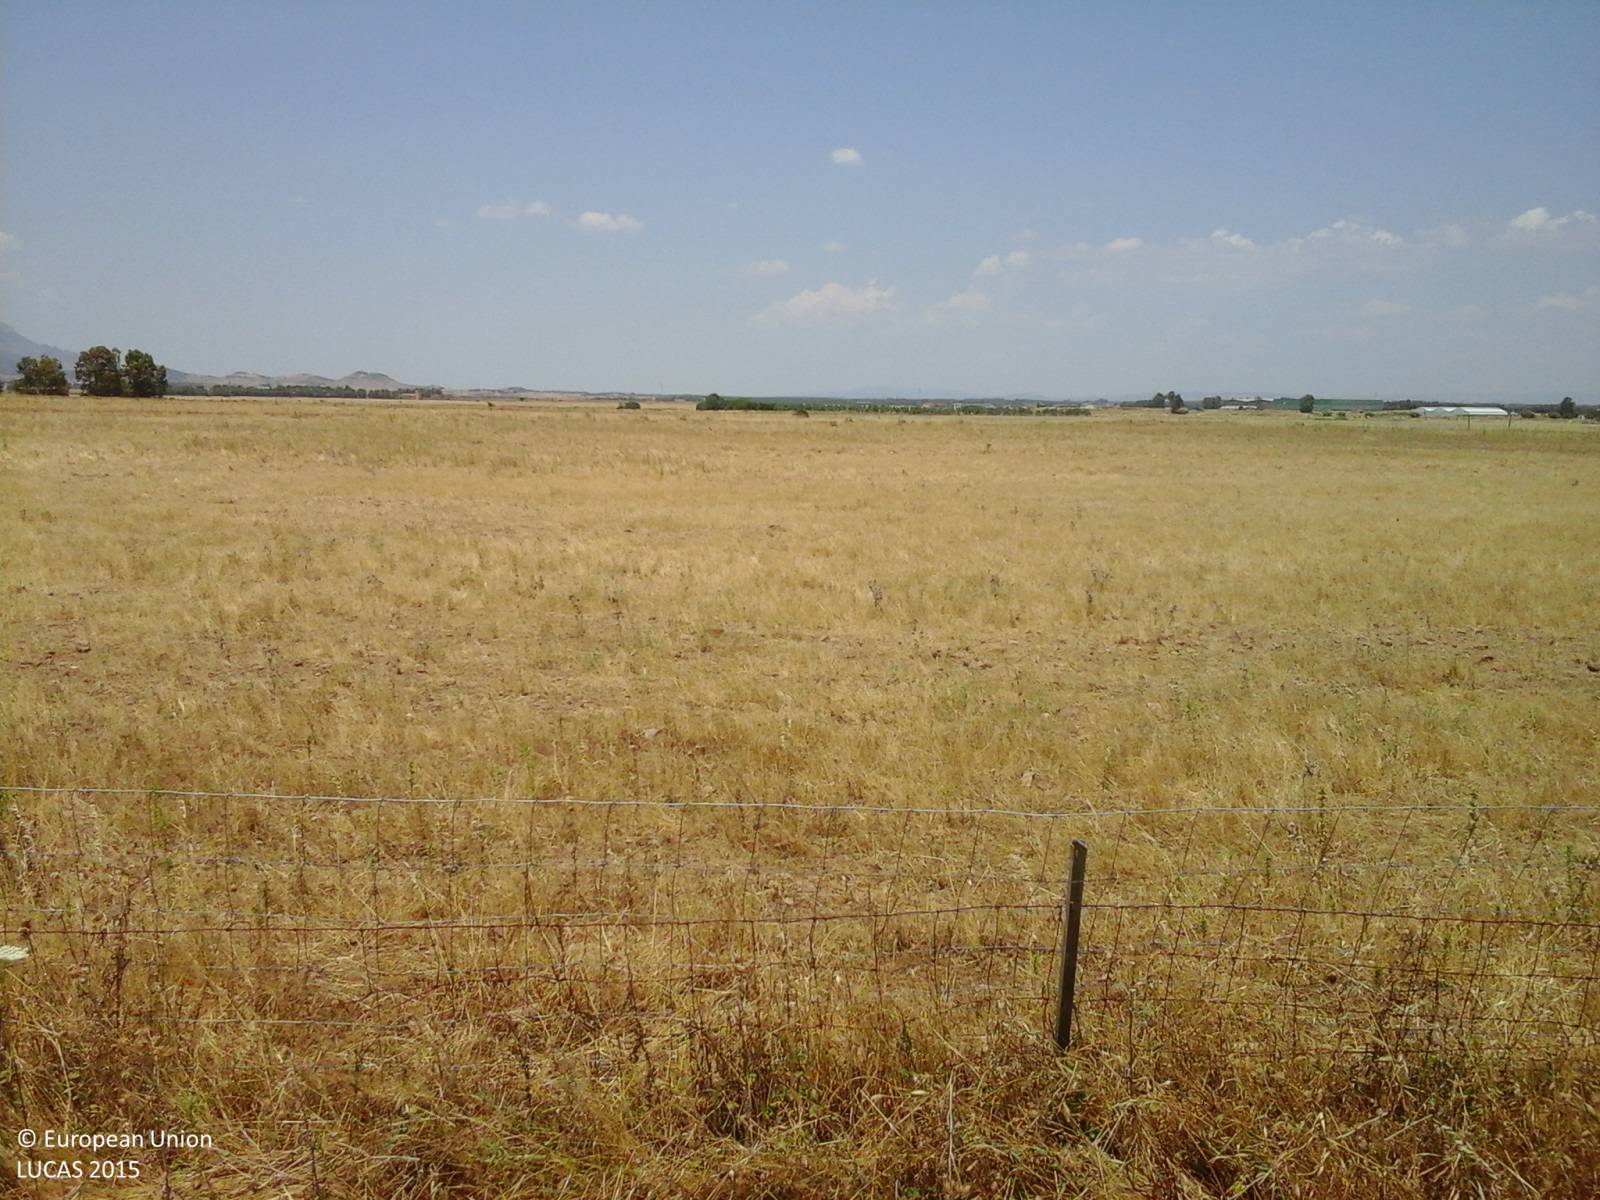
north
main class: Grassland
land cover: Spontaneously vegetated surfaces
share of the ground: > 75 %
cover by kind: herbaceous plants 85 %, unconsolidated bare surface 15 %
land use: Agriculture (excluding fallow land and kitchen gardens)
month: June
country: IT
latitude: 39.3369
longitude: 8.8584
